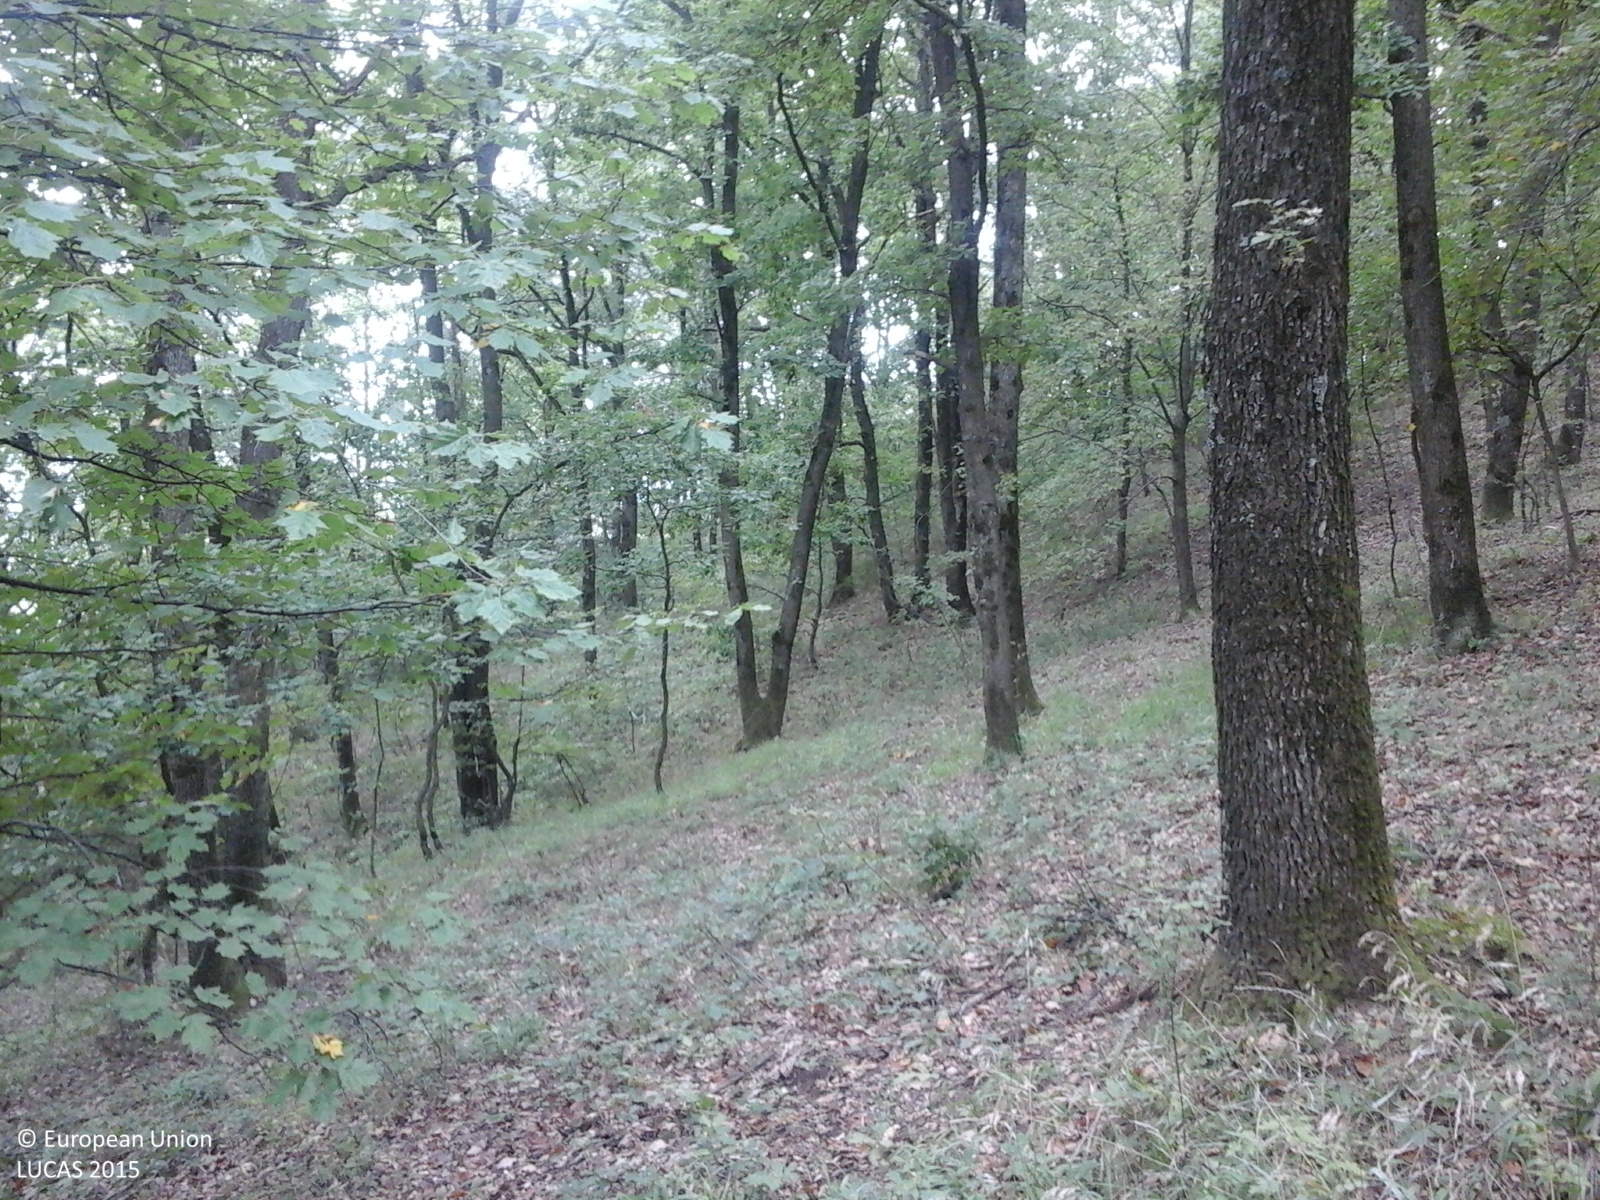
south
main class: Woodland
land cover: Broadleaved woodland
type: acidophilous oak and oak-birch forest
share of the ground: > 75 %
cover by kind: broadleaved forest trees 100 %
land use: Forestry
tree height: > 5 m
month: September
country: RO
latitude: 47.0781
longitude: 22.2868
